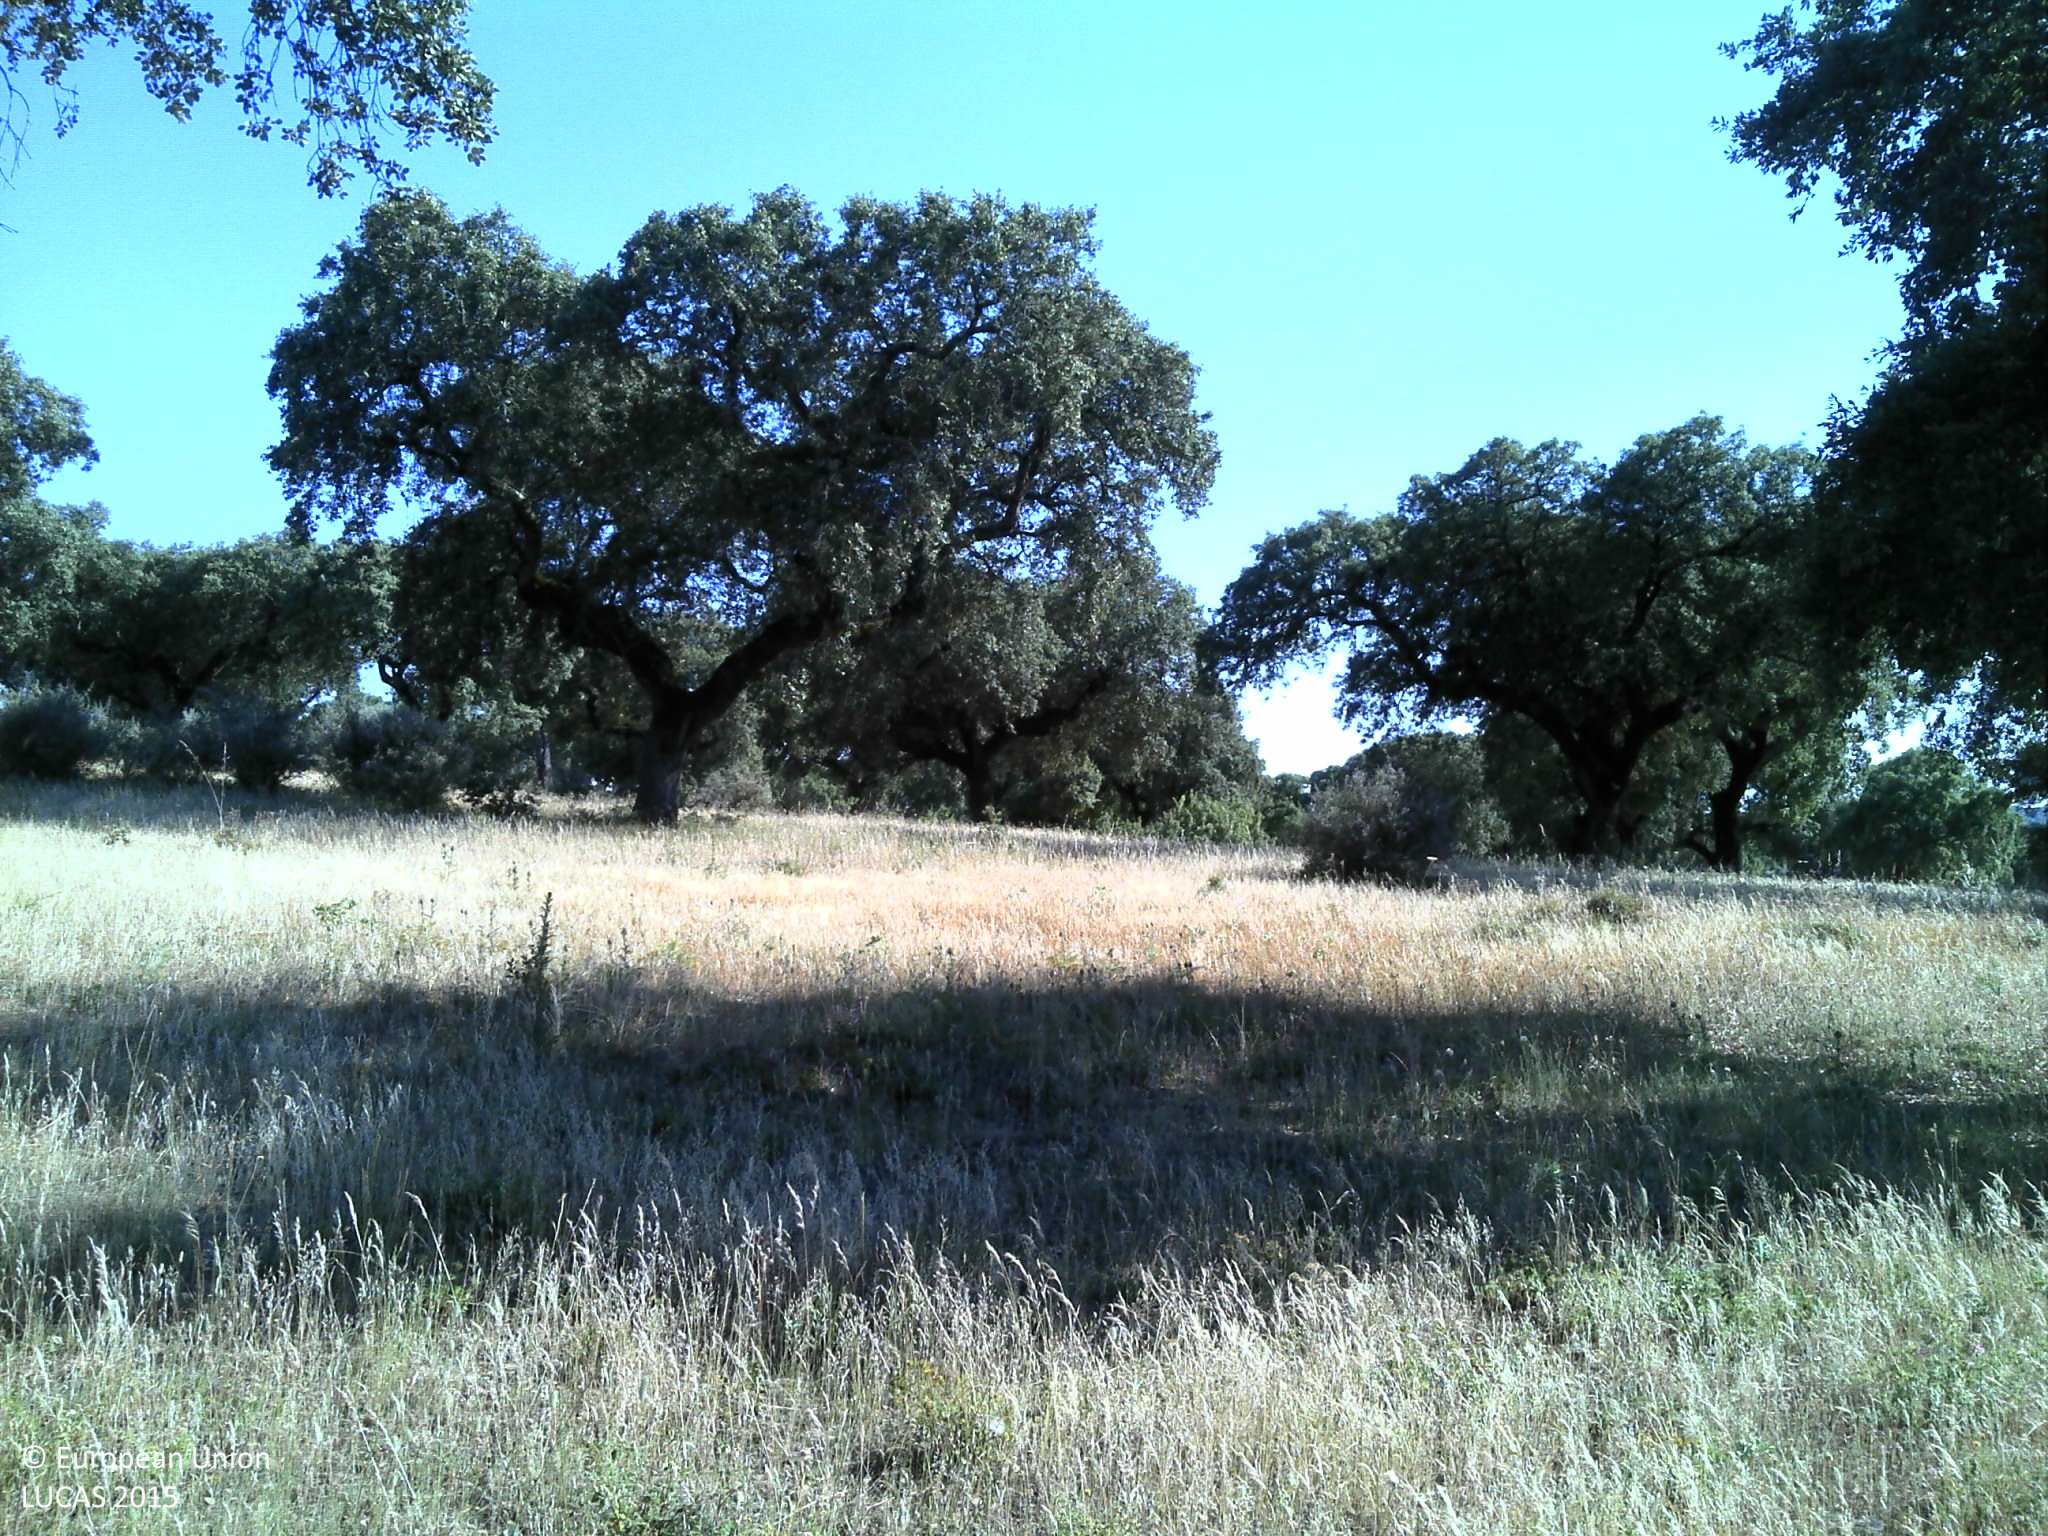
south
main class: Woodland
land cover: Broadleaved woodland
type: broadleaved evergreen forest
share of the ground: 25 - 50 %
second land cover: Grassland without tree/shrub cover
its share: 50 - 75 %
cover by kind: herbaceous plants 60 %, broadleaved forest trees 30 %, unconsolidated bare surface 10 %
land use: Forestry
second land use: Agriculture (excluding fallow land and kitchen gardens)
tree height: > 5 m
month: June
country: PT
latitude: 38.7306
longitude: -8.1193
